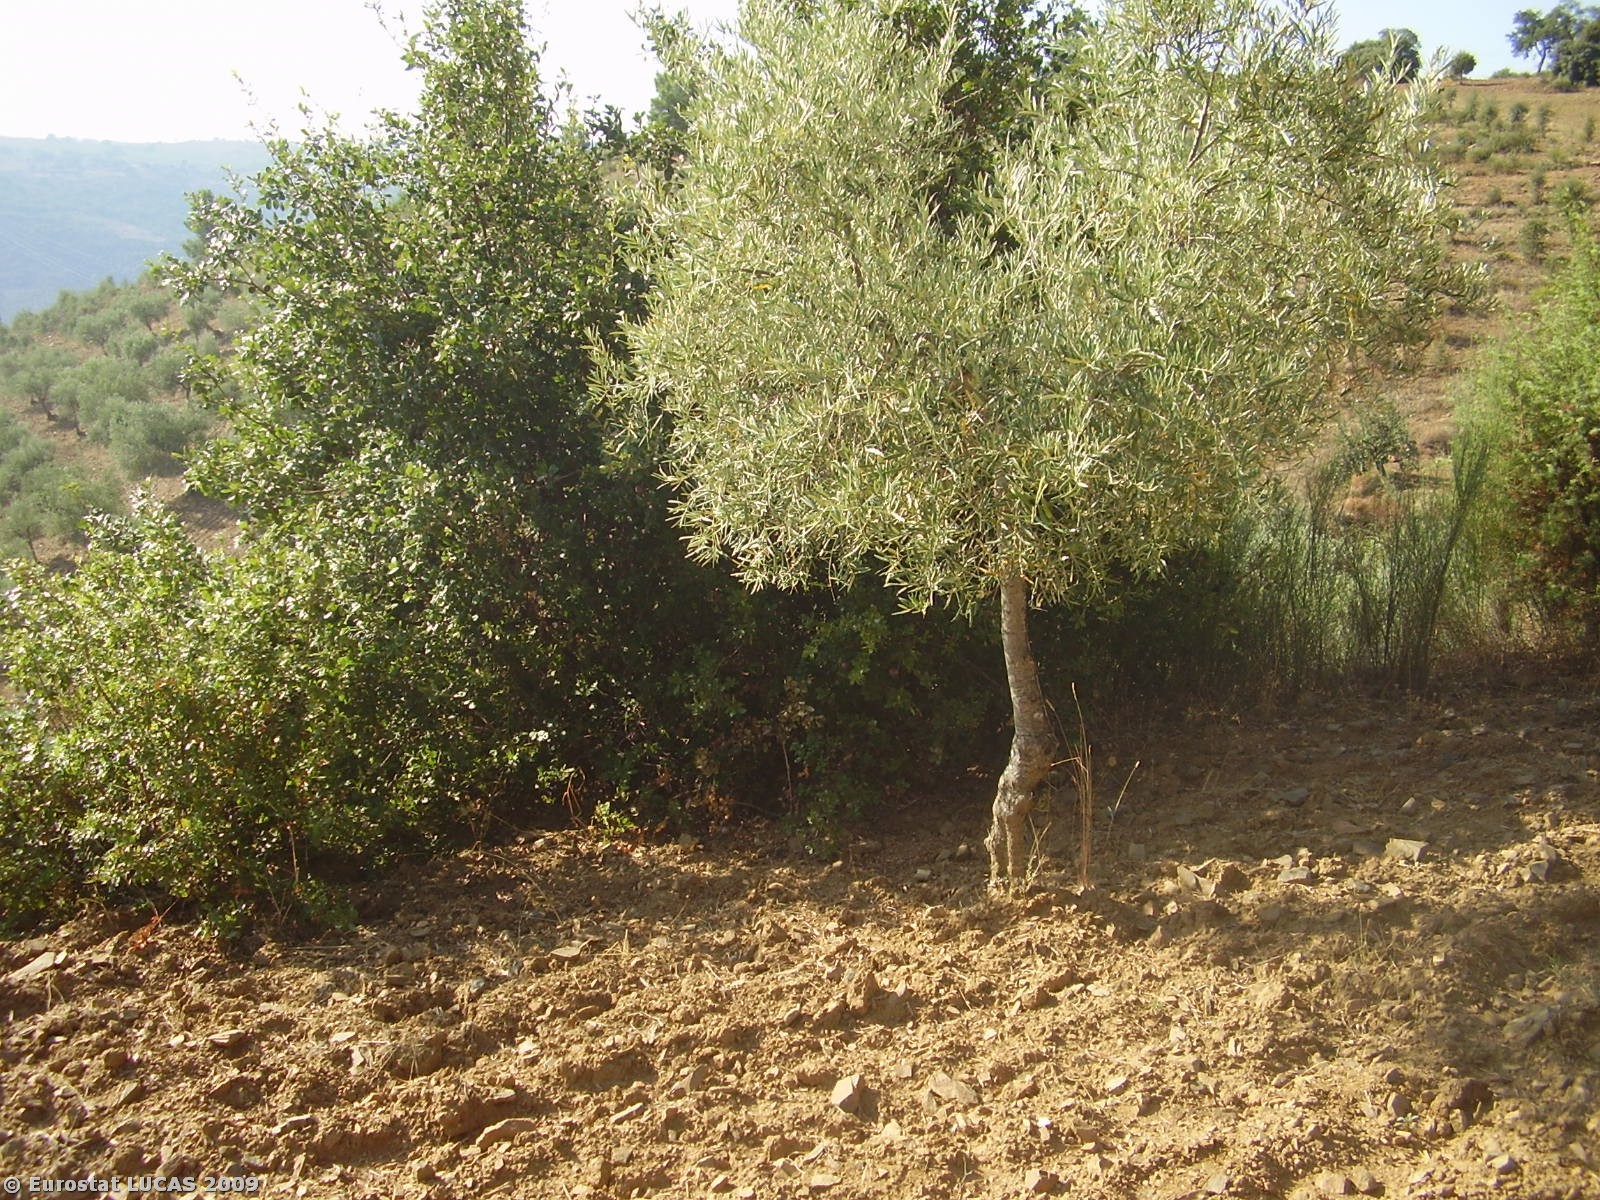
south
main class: Cropland
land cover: Olive groves
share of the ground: 10 - 25 %
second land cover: Bare land
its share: > 75 %
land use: Agriculture (excluding fallow land and kitchen gardens)
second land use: Fallow land
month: August
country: PT
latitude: 41.4014
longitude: -6.8187
